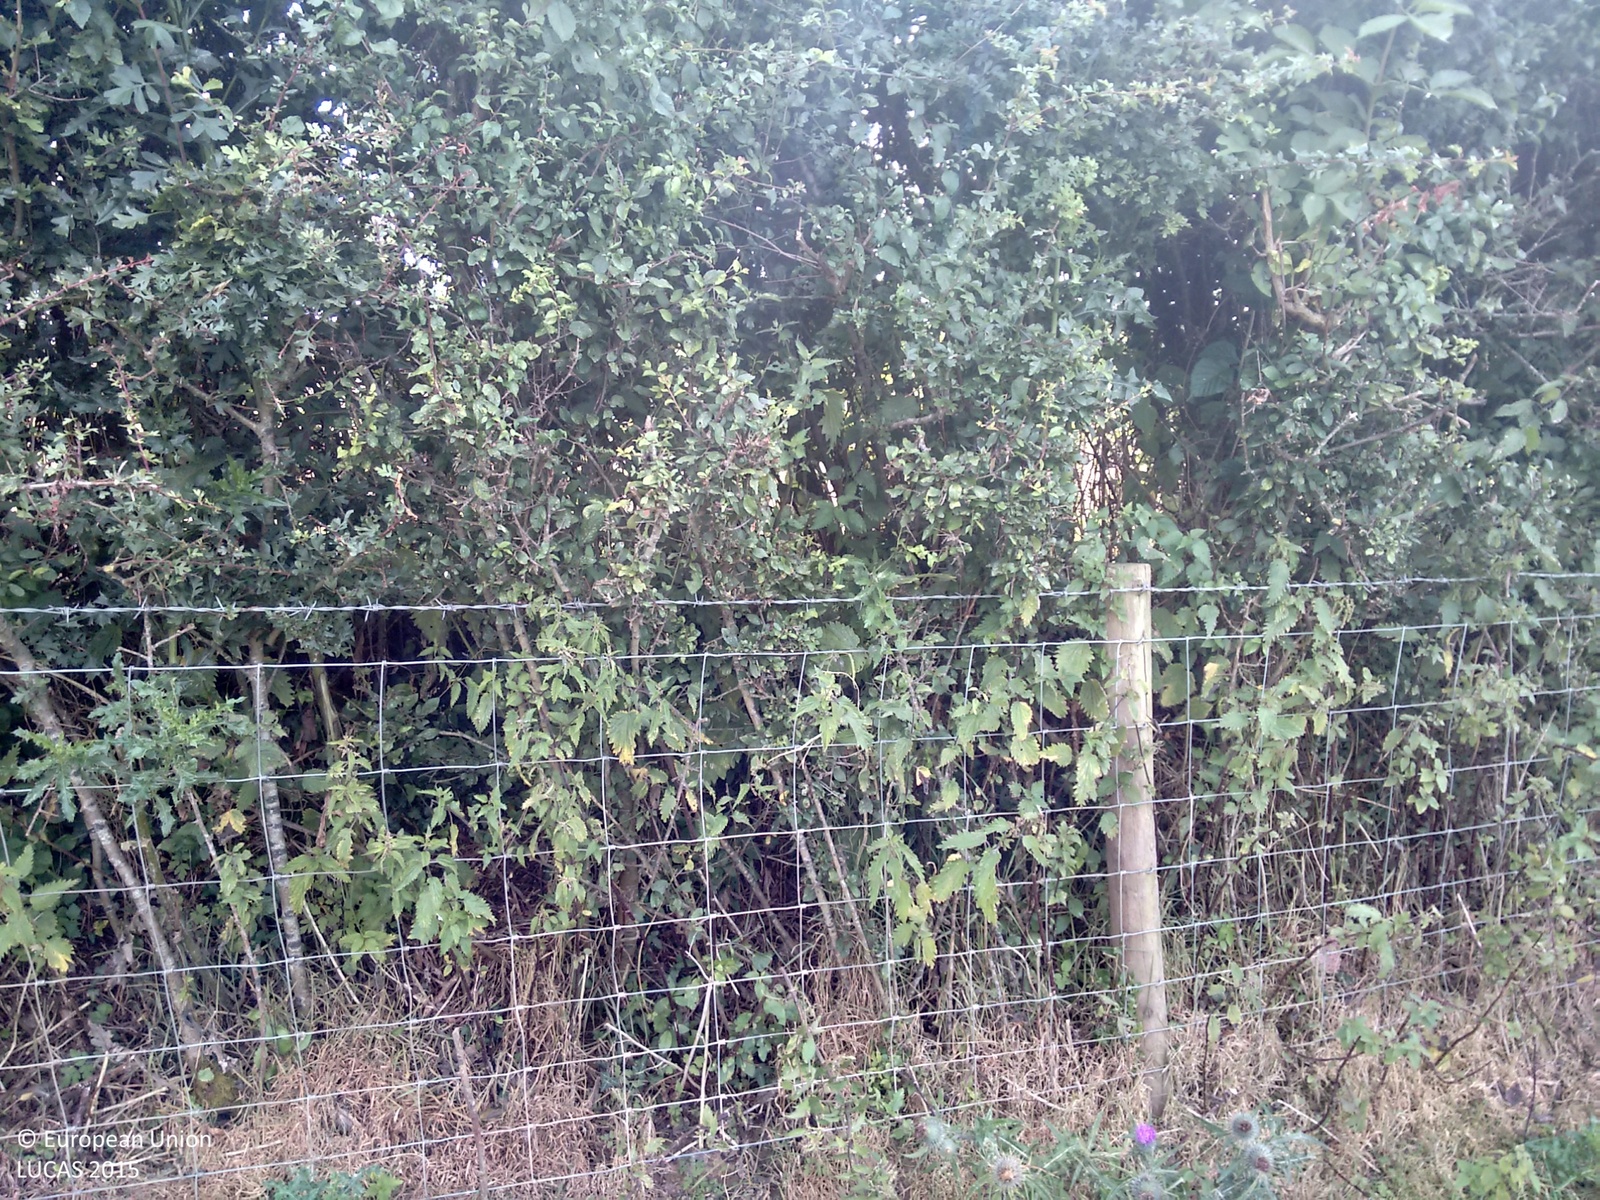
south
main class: Grassland
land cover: Grassland without tree/shrub cover
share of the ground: > 75 %
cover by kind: herbaceous plants 100 %
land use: Agriculture (excluding fallow land and kitchen gardens)
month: August
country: GB
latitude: 54.7931
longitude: -3.3449
